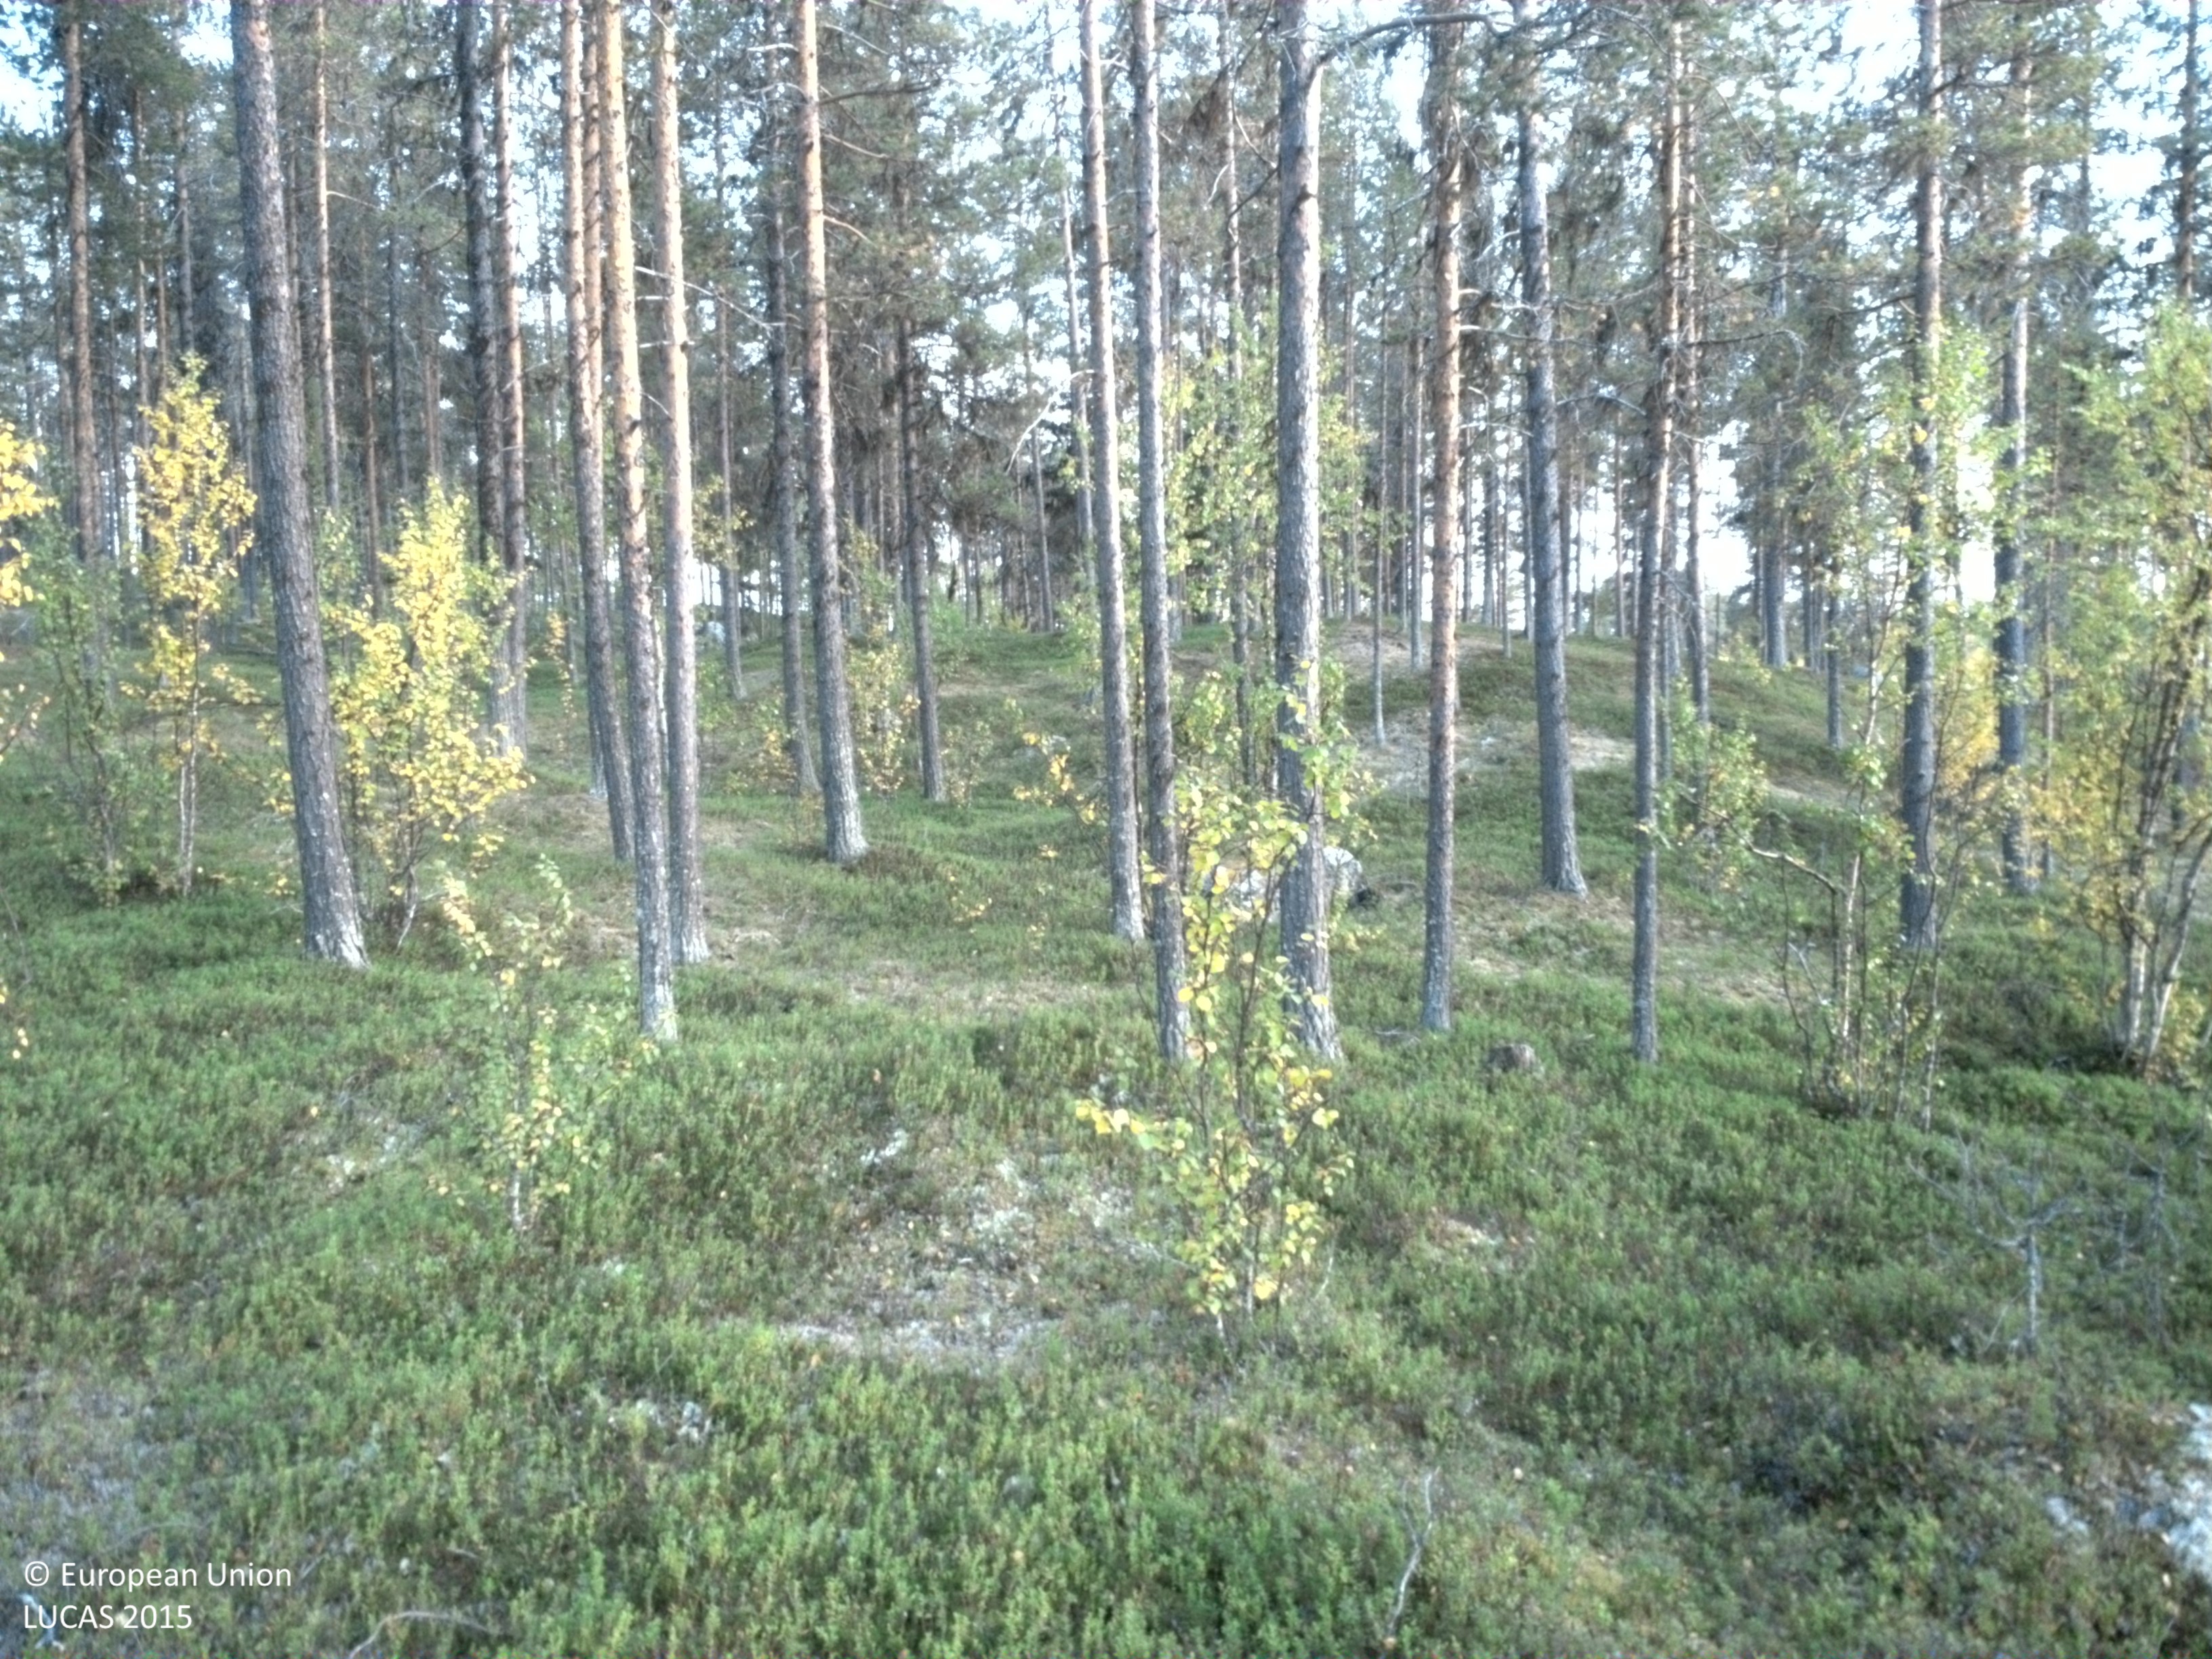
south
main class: Woodland
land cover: Pine dominated mixed woodland
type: boreal forest
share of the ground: 25 - 50 %
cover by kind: shrubs 45 %, broadleaved forest trees 30 %, lichens and mosses 15 %, coniferous forest trees 10 %
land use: Forestry
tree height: > 5 m
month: September
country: SE
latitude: 65.3293
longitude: 16.6398
